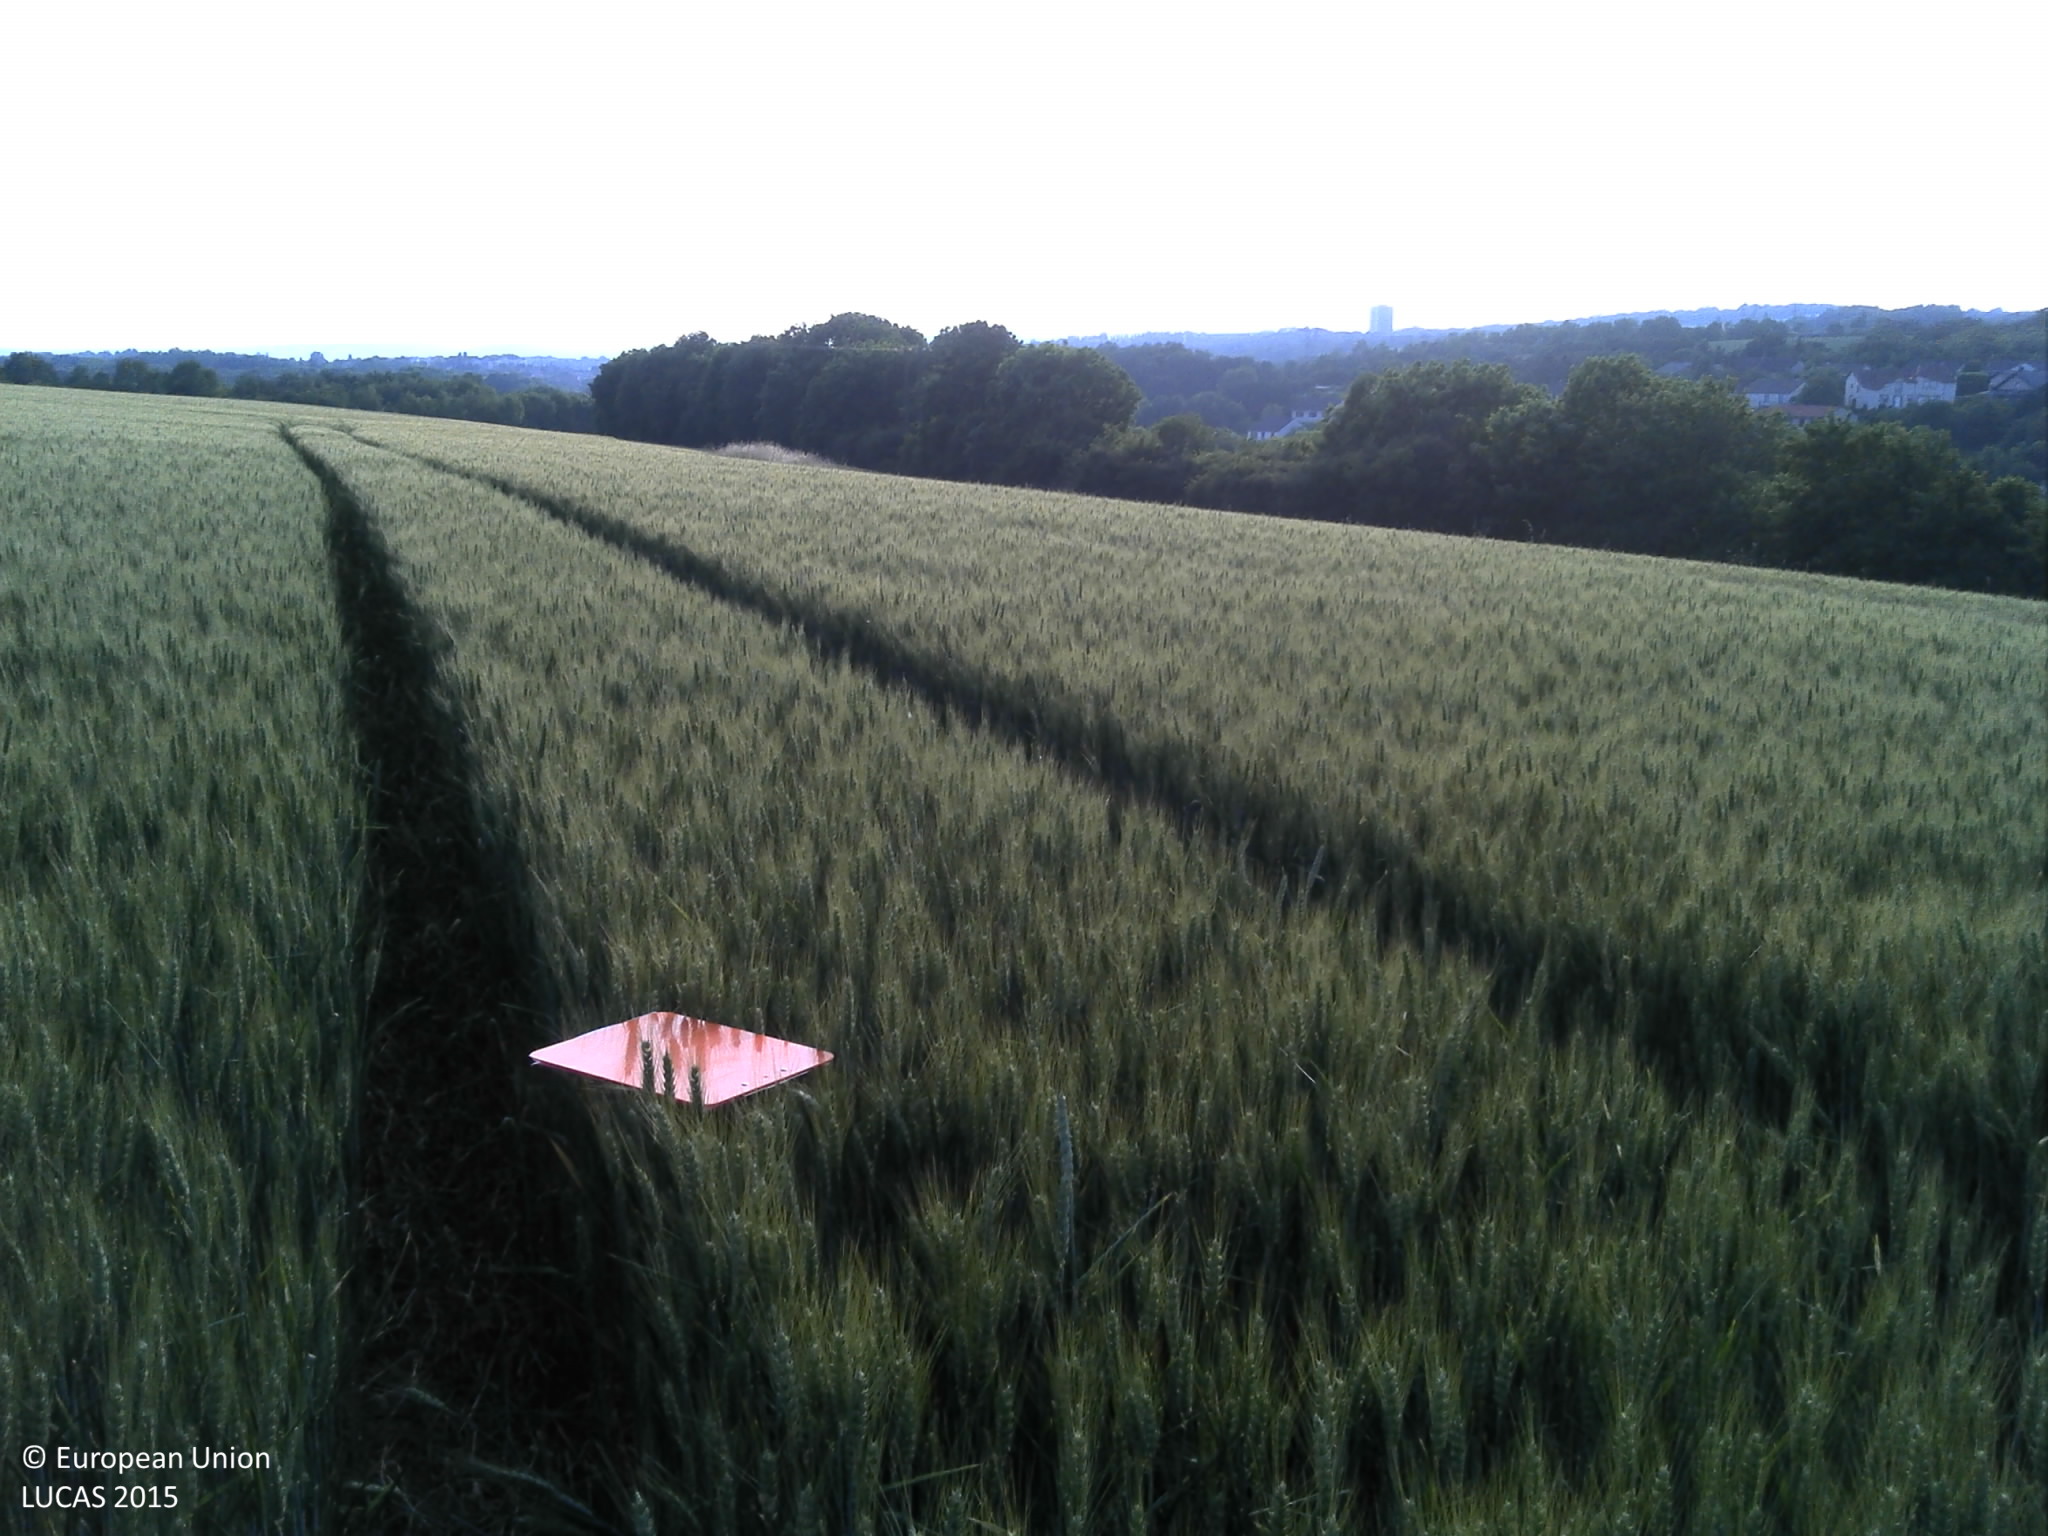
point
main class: Cropland
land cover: Common wheat
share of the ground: > 75 %
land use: Agriculture (excluding fallow land and kitchen gardens)
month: June
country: FR
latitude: 49.1326
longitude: 6.2582
